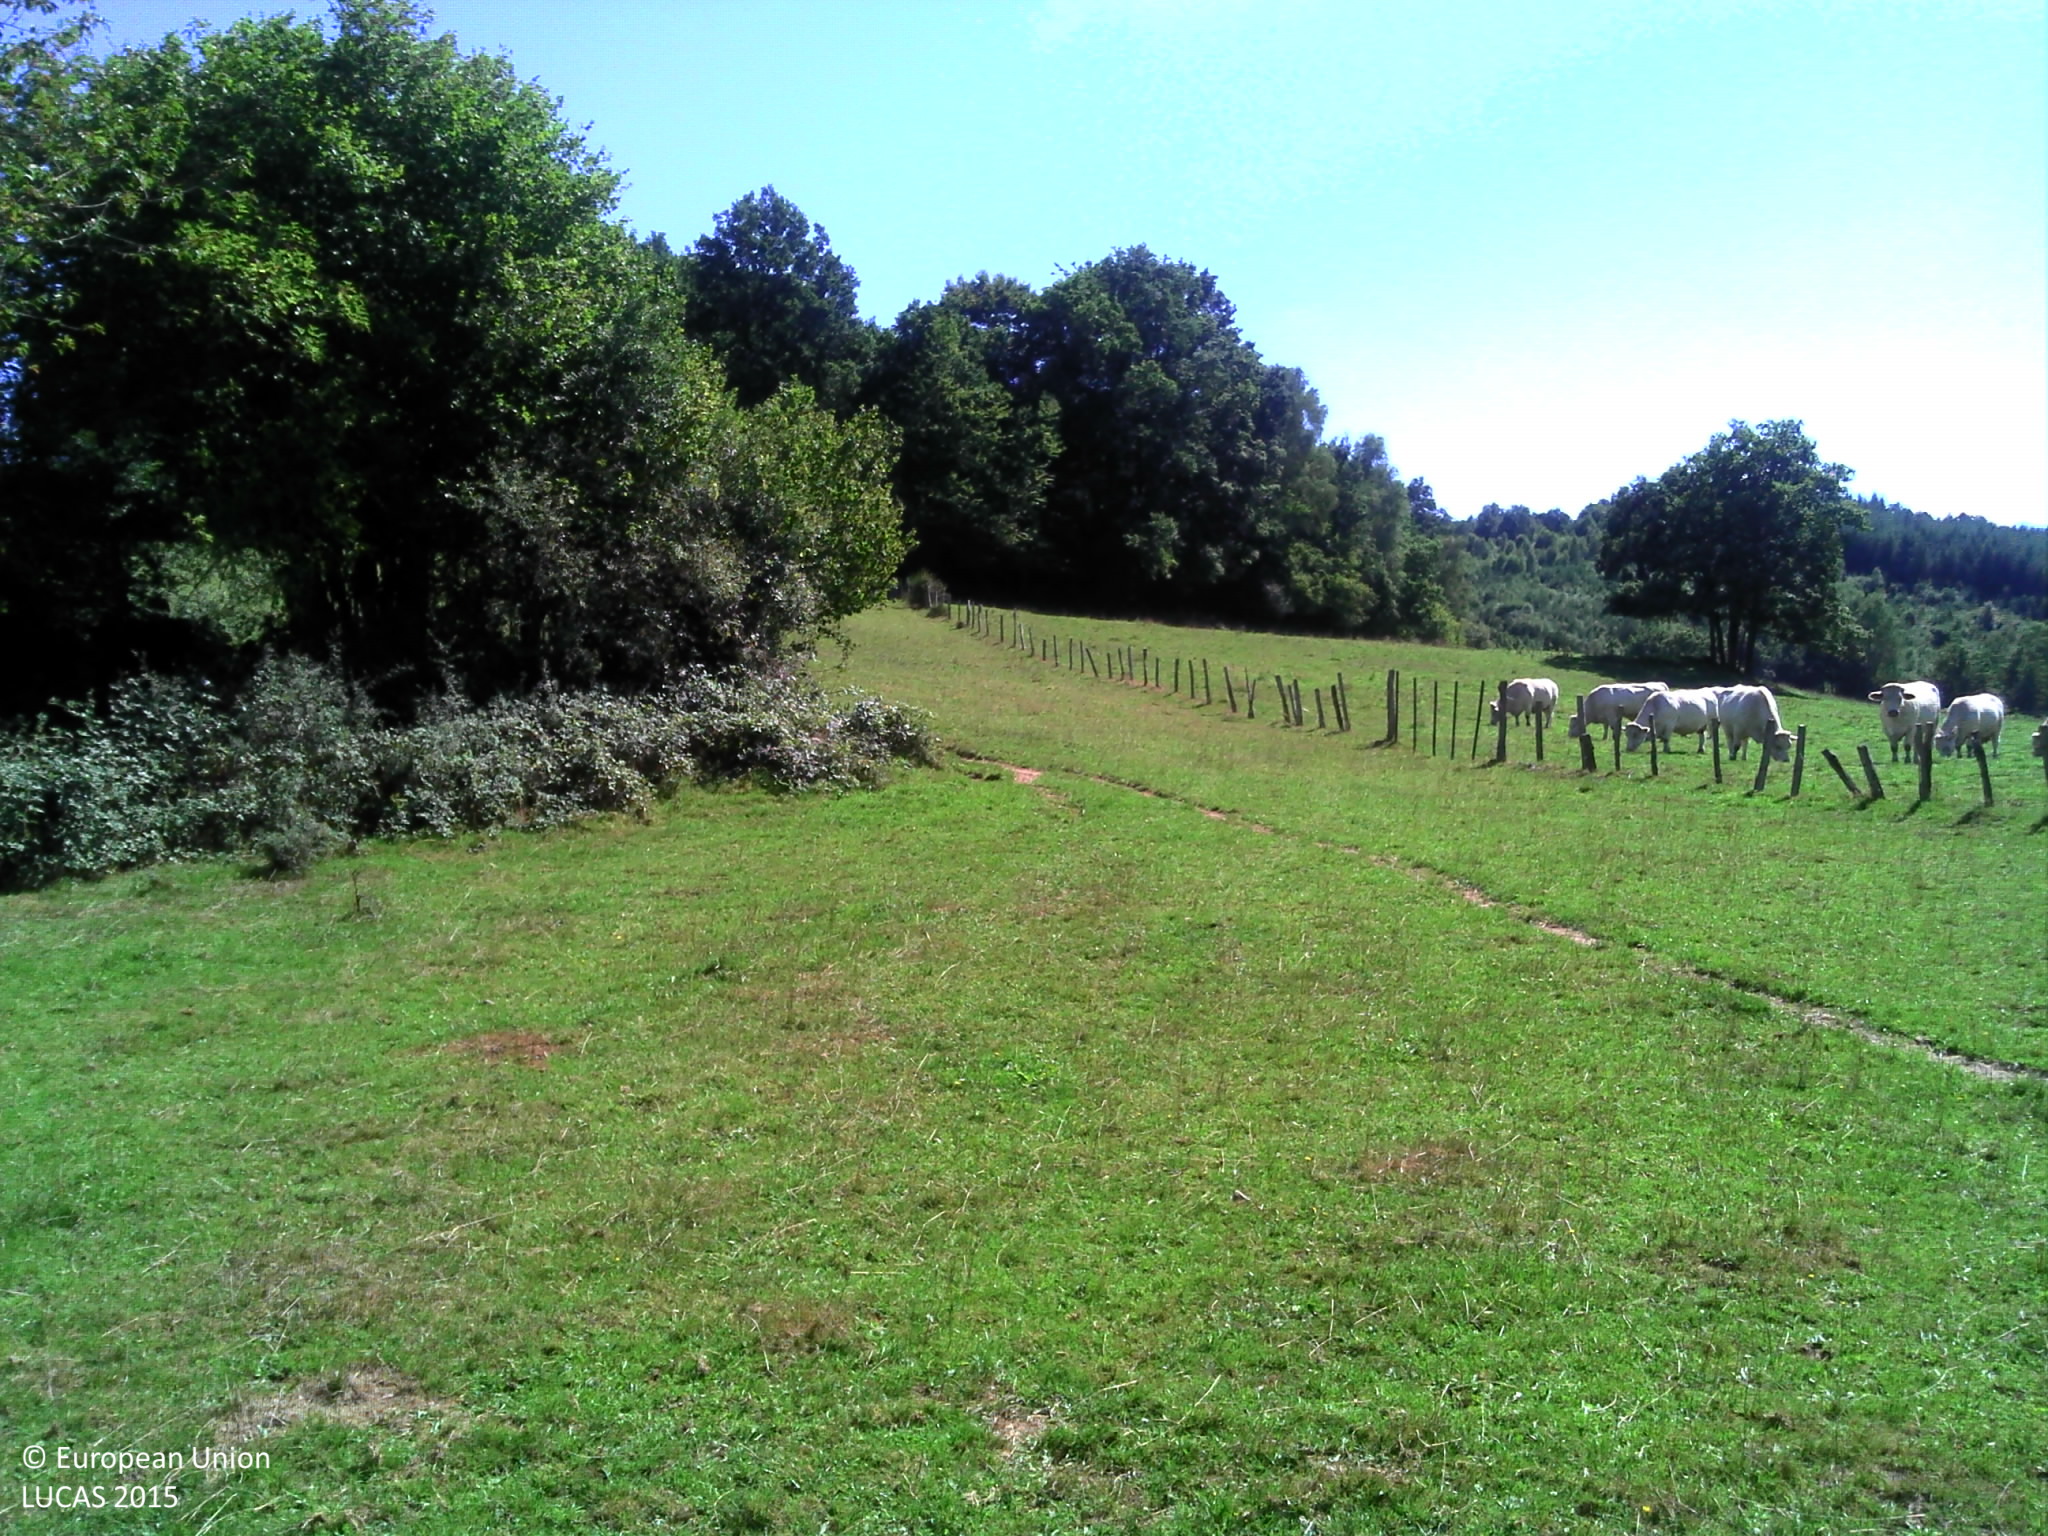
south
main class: Grassland
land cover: Grassland without tree/shrub cover
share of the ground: > 75 %
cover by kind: herbaceous plants 100 %
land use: Agriculture (excluding fallow land and kitchen gardens)
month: August
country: FR
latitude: 45.8710
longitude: 2.2537
